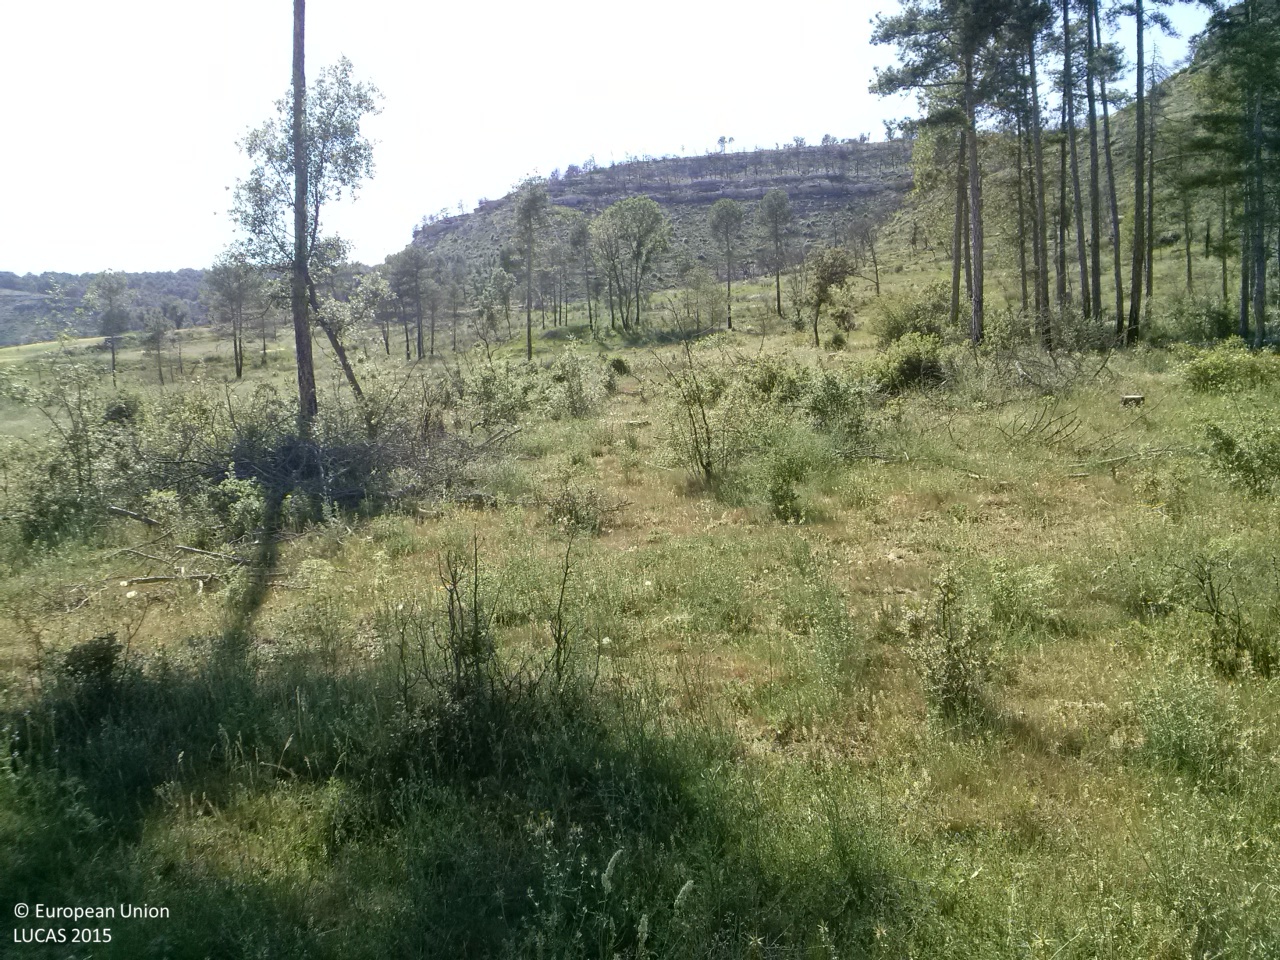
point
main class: Grassland
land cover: Grassland with sparse tree/shrub cover
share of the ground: > 75 %
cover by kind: herbaceous plants 90 %, coniferous forest trees 5 %, shrubs 5 %
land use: Agriculture (excluding fallow land and kitchen gardens)
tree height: > 5 m
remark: Burnt area
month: June
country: ES
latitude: 39.8690
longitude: -1.9011
